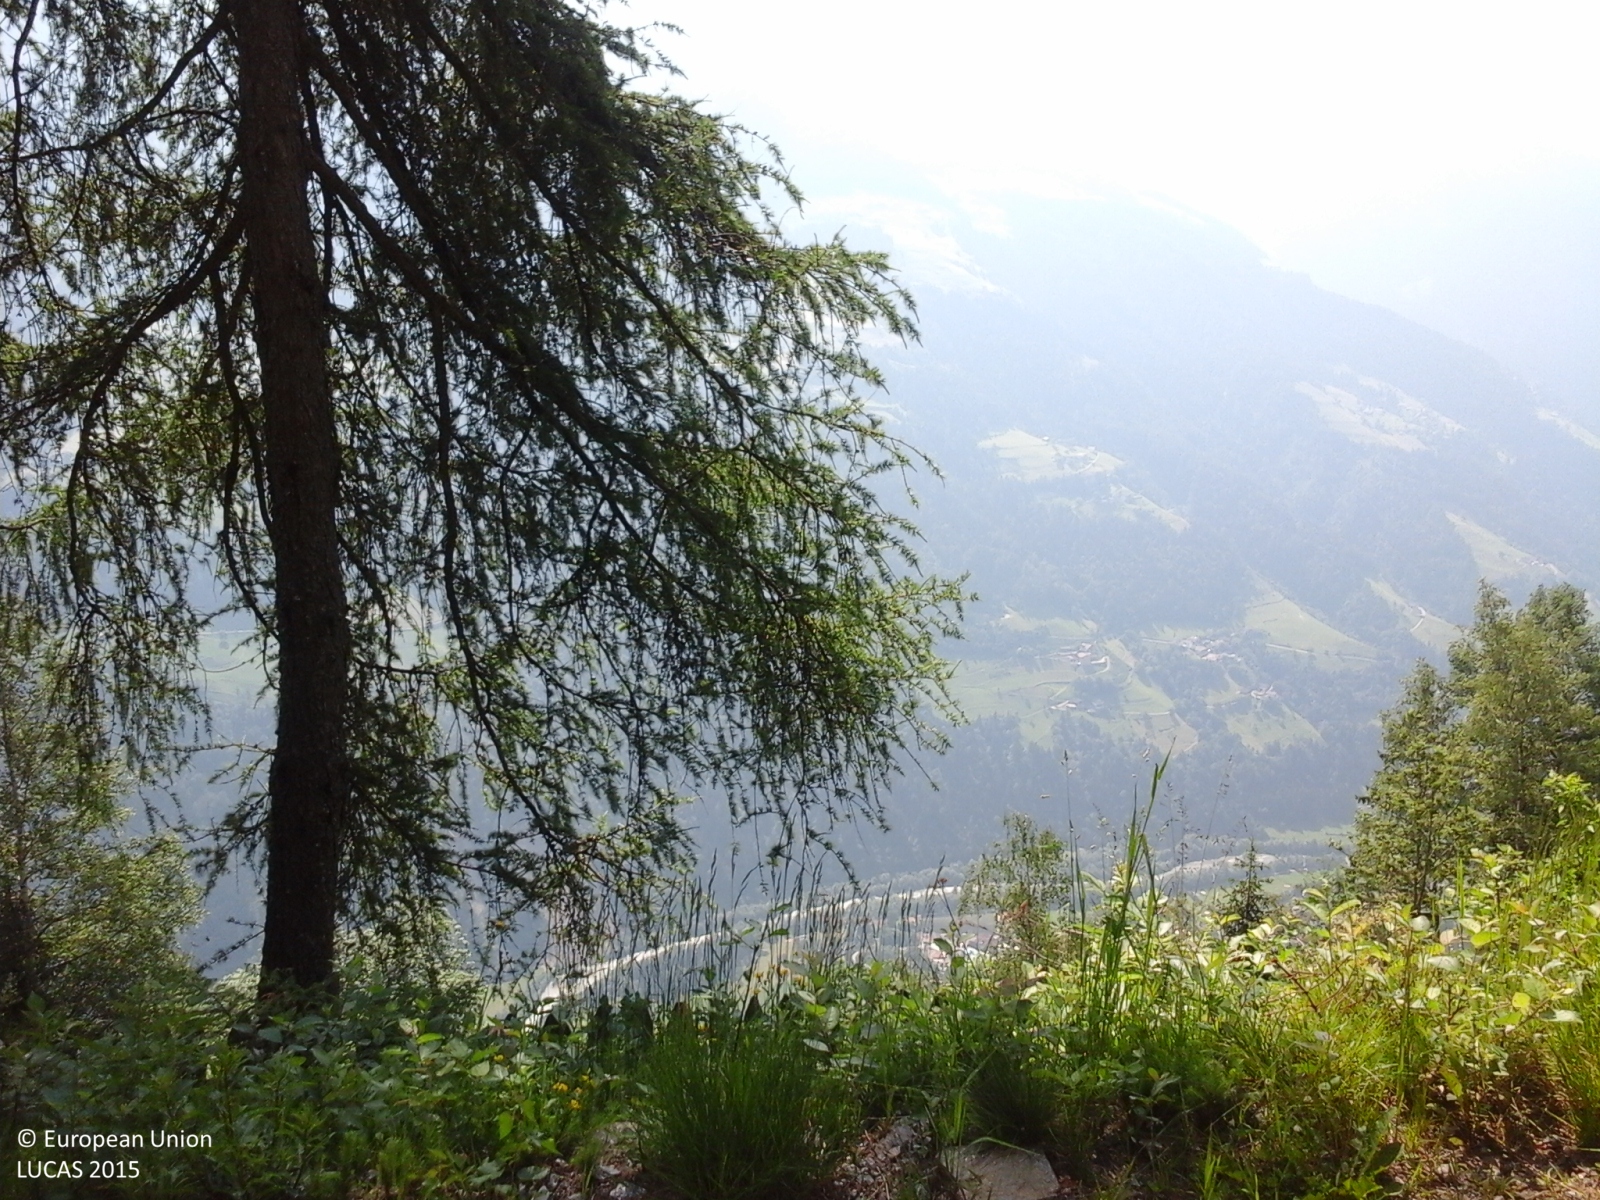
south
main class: Woodland
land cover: Spruce dominated coniferous woodland
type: alpine coniferous forest
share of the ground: > 75 %
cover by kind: coniferous forest trees 100 %
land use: Forestry
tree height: > 5 m
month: June
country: IT
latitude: 46.7589
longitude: 11.1901
